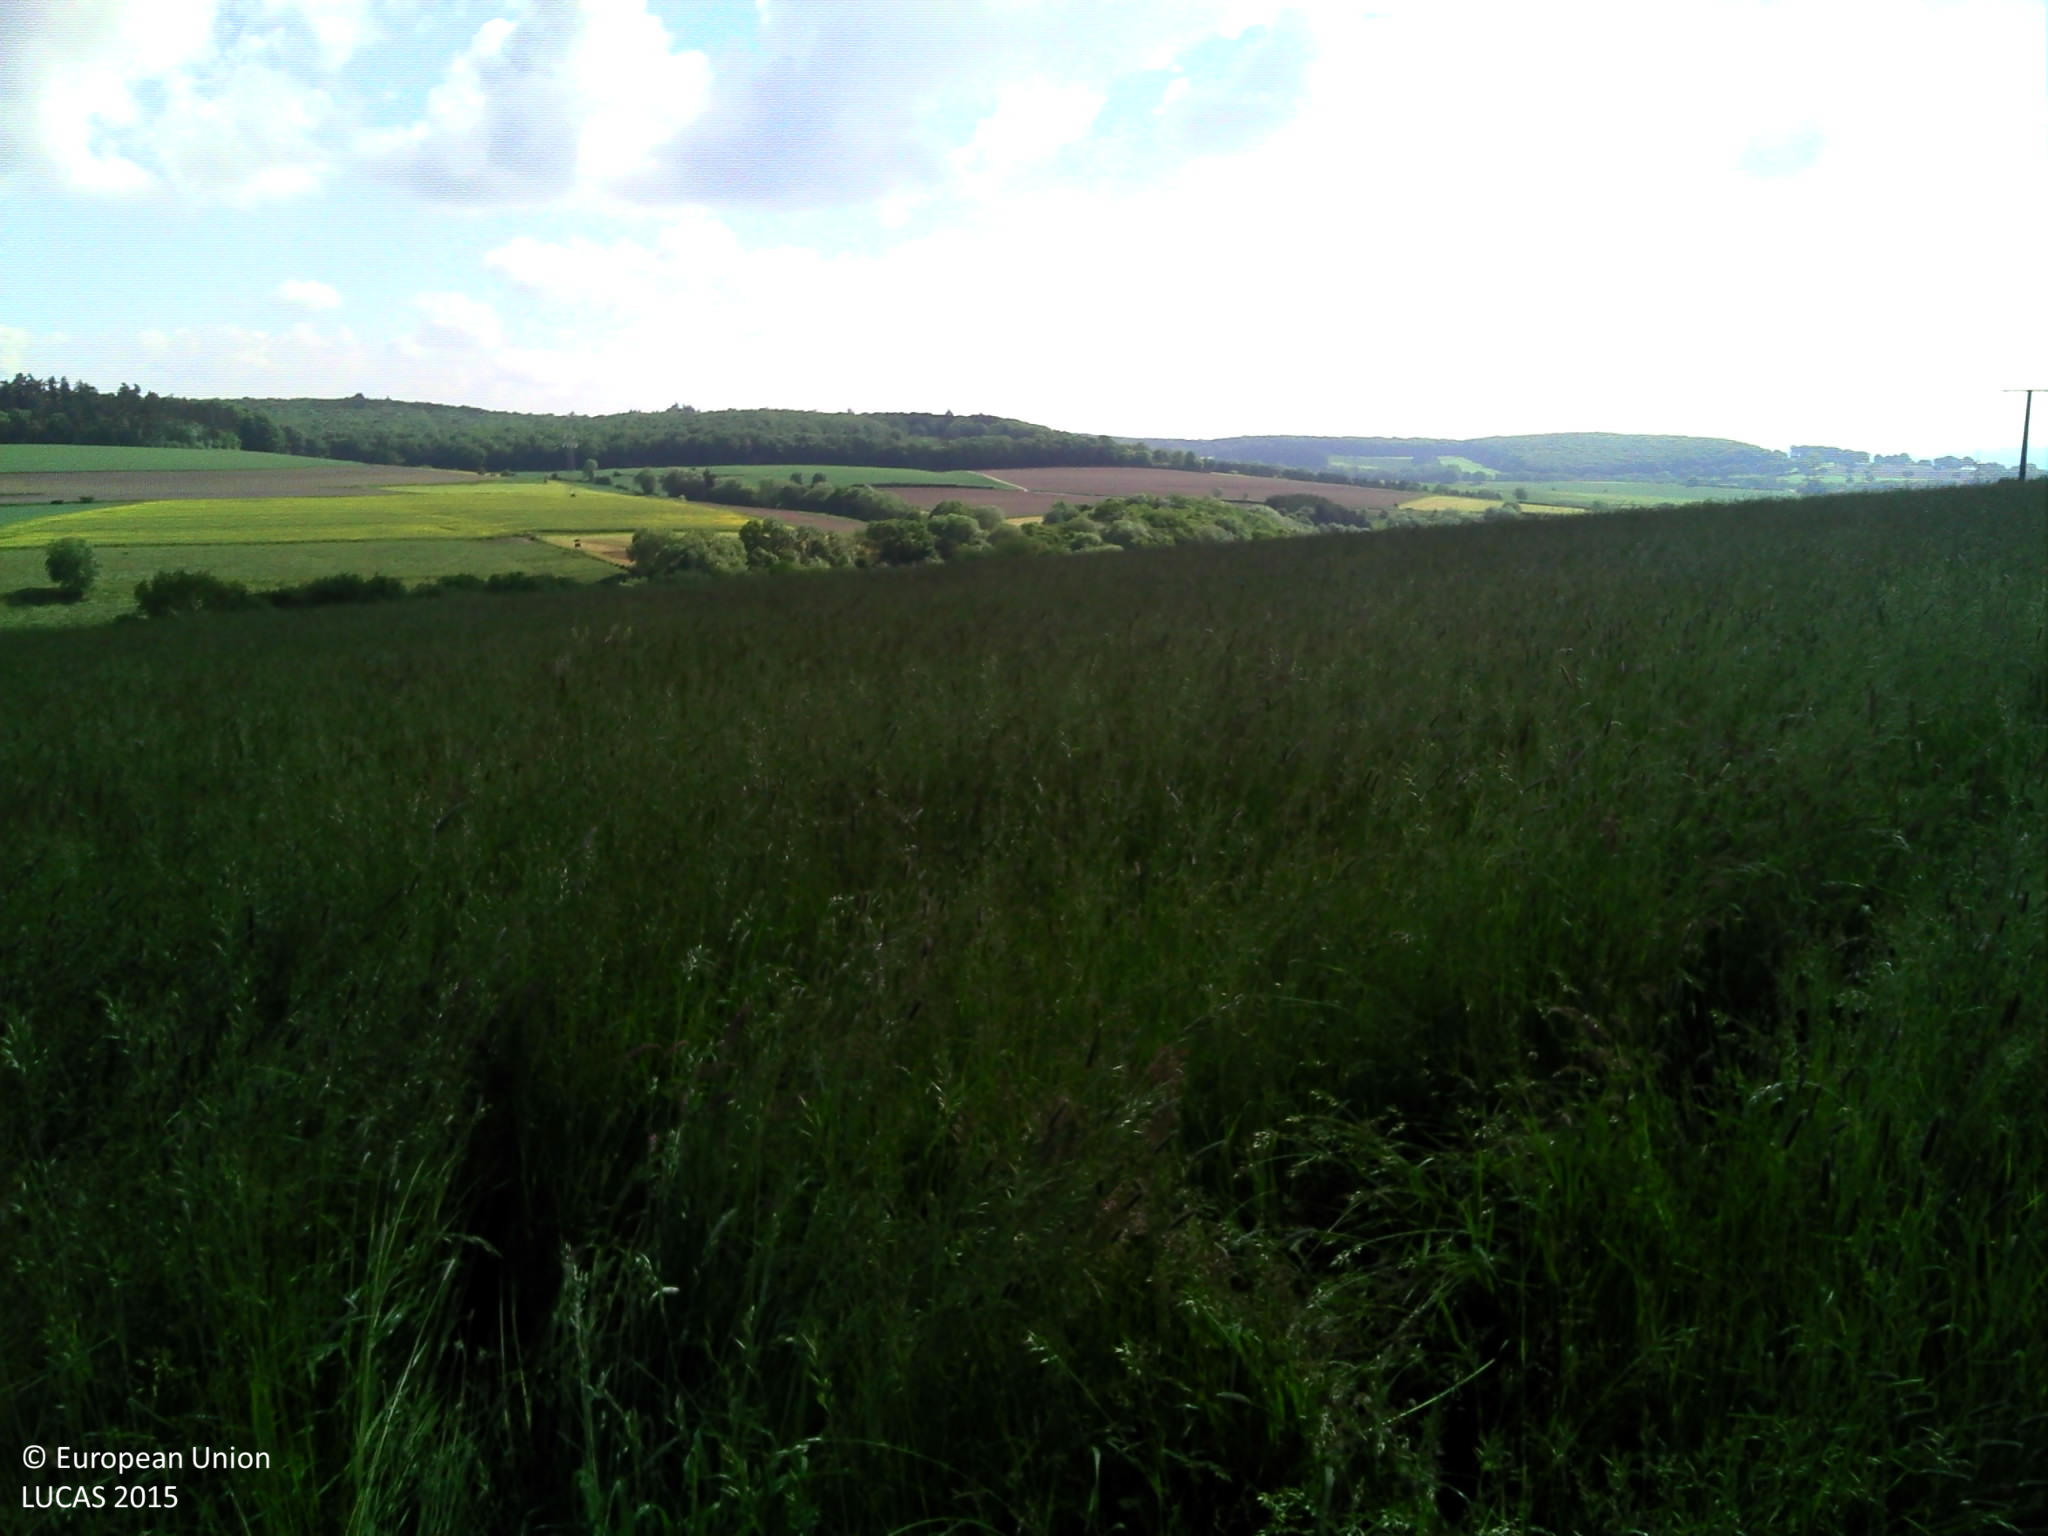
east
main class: Grassland
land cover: Grassland without tree/shrub cover
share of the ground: > 75 %
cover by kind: herbaceous plants 100 %
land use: Agriculture (excluding fallow land and kitchen gardens)
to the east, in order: Grassland without tree/shrub cover; Barley; Fences; Grass margins; Tracks; Grass margins; Abandoned hedges; Fences; Grassland with sparse tree/shrub cover
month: May
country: LU
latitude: 49.7119
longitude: 6.3523
